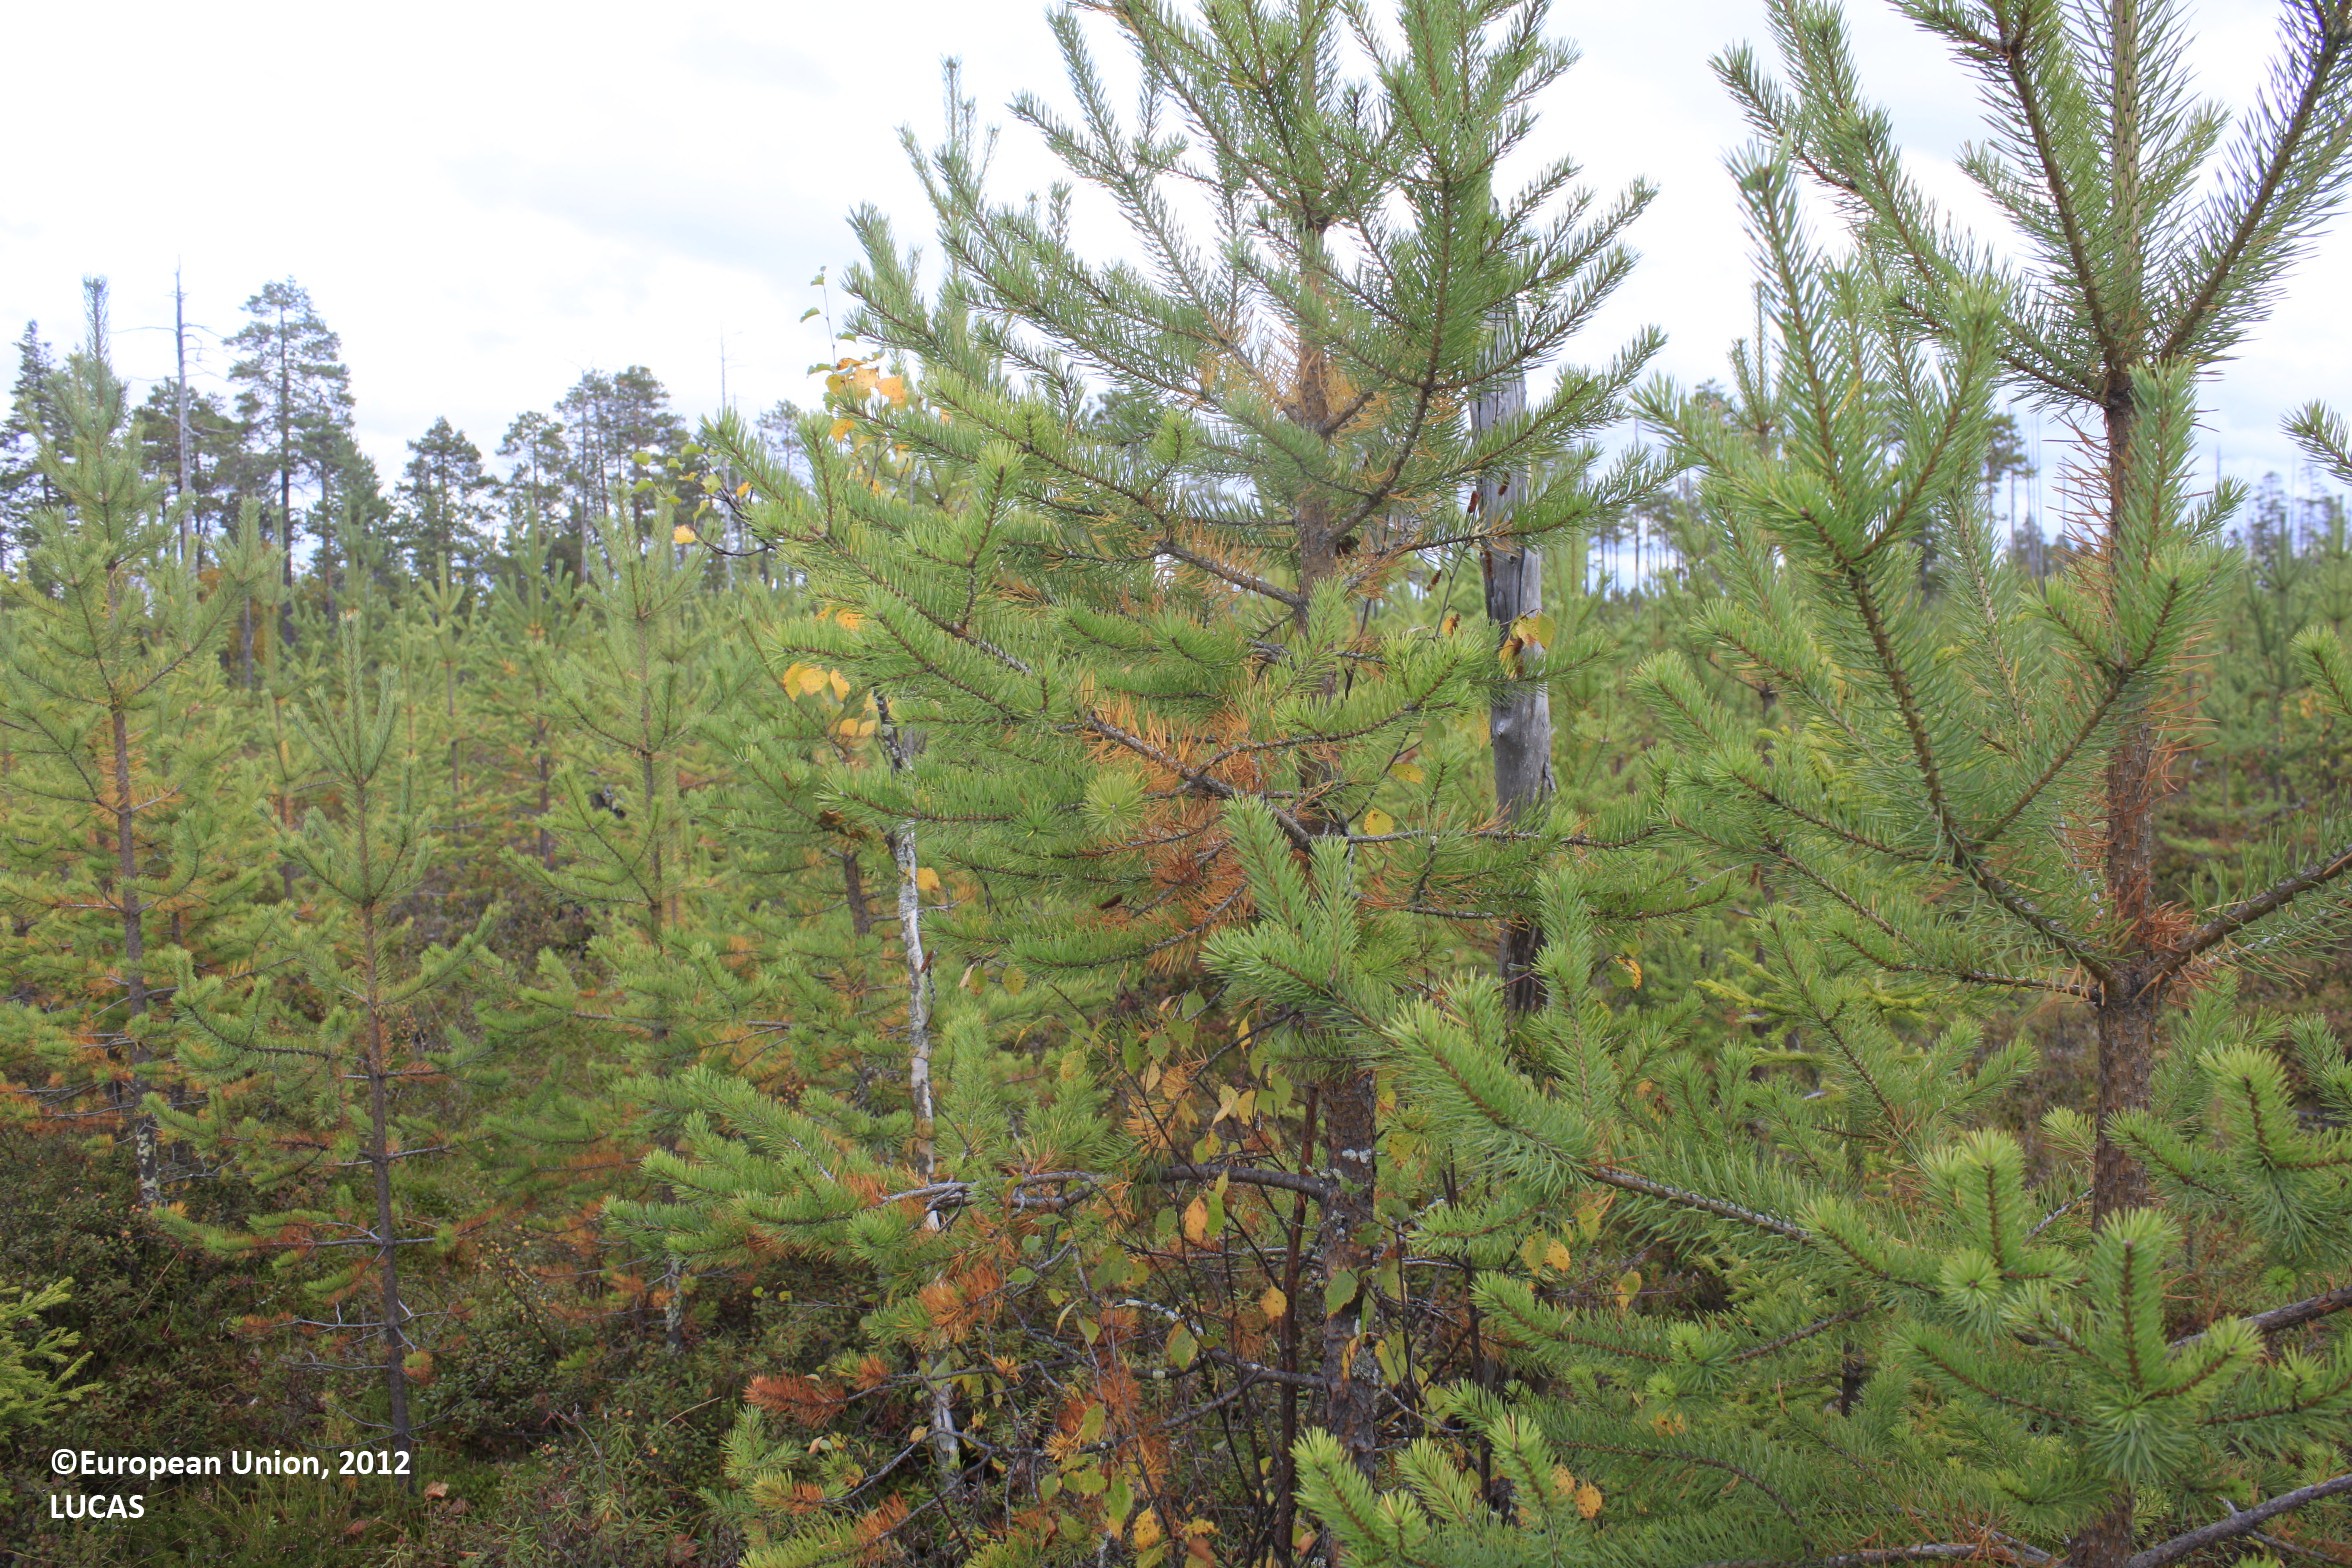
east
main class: Woodland
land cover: Pine dominated coniferous woodland
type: boreal forest
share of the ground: 50 - 75 %
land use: Forestry
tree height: < 5 m
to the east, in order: Pine dominated coniferous woodland; Ditches and canals; Pine dominated coniferous woodland; Ditches and canals; Pine dominated coniferous woodland; Ditches and canals; Pine dominated coniferous woodland; Ditches and canals; Pine dominated coniferous woodland; Ditches and canals; Pine dominated coniferous woodland; Ditches and canals; Pine dominated coniferous woodland
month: September
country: FI
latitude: 65.4320
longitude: 27.0820
